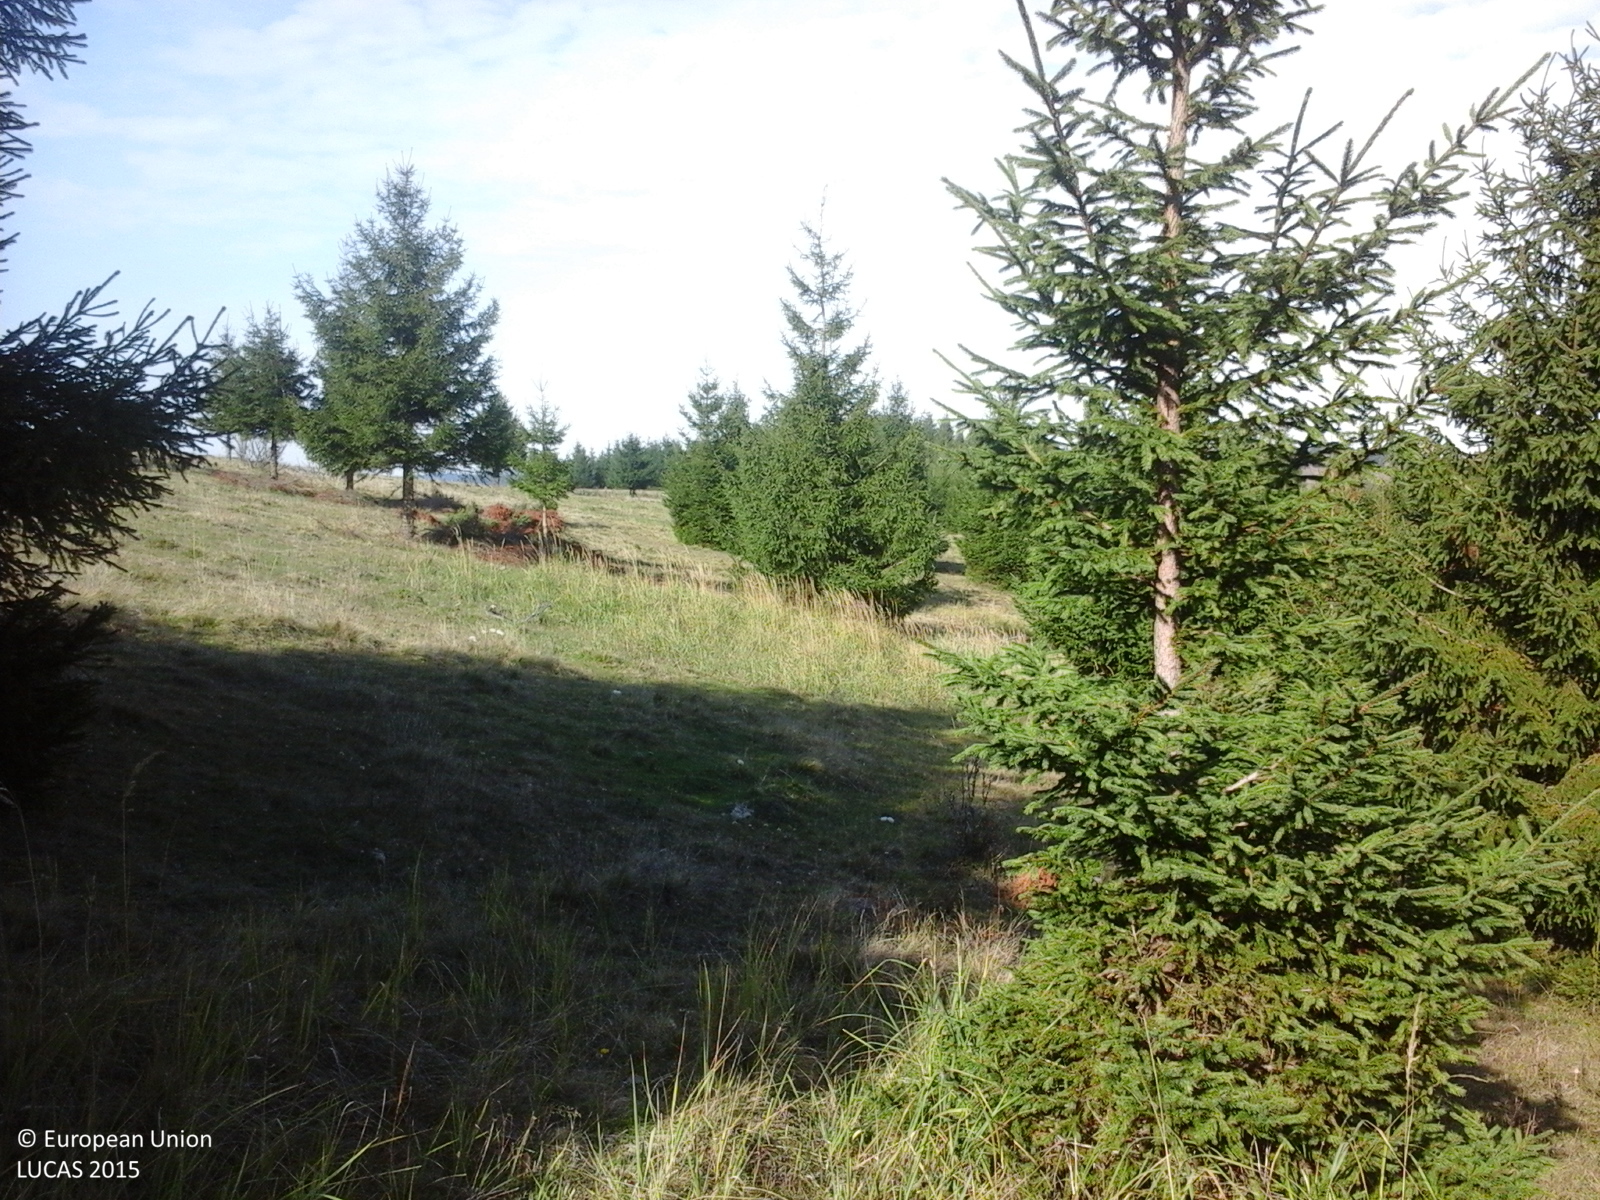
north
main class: Grassland
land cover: Grassland without tree/shrub cover
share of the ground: > 75 %
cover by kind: herbaceous plants 100 %
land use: Forestry
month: October
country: RO
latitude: 46.2195
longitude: 25.9994
